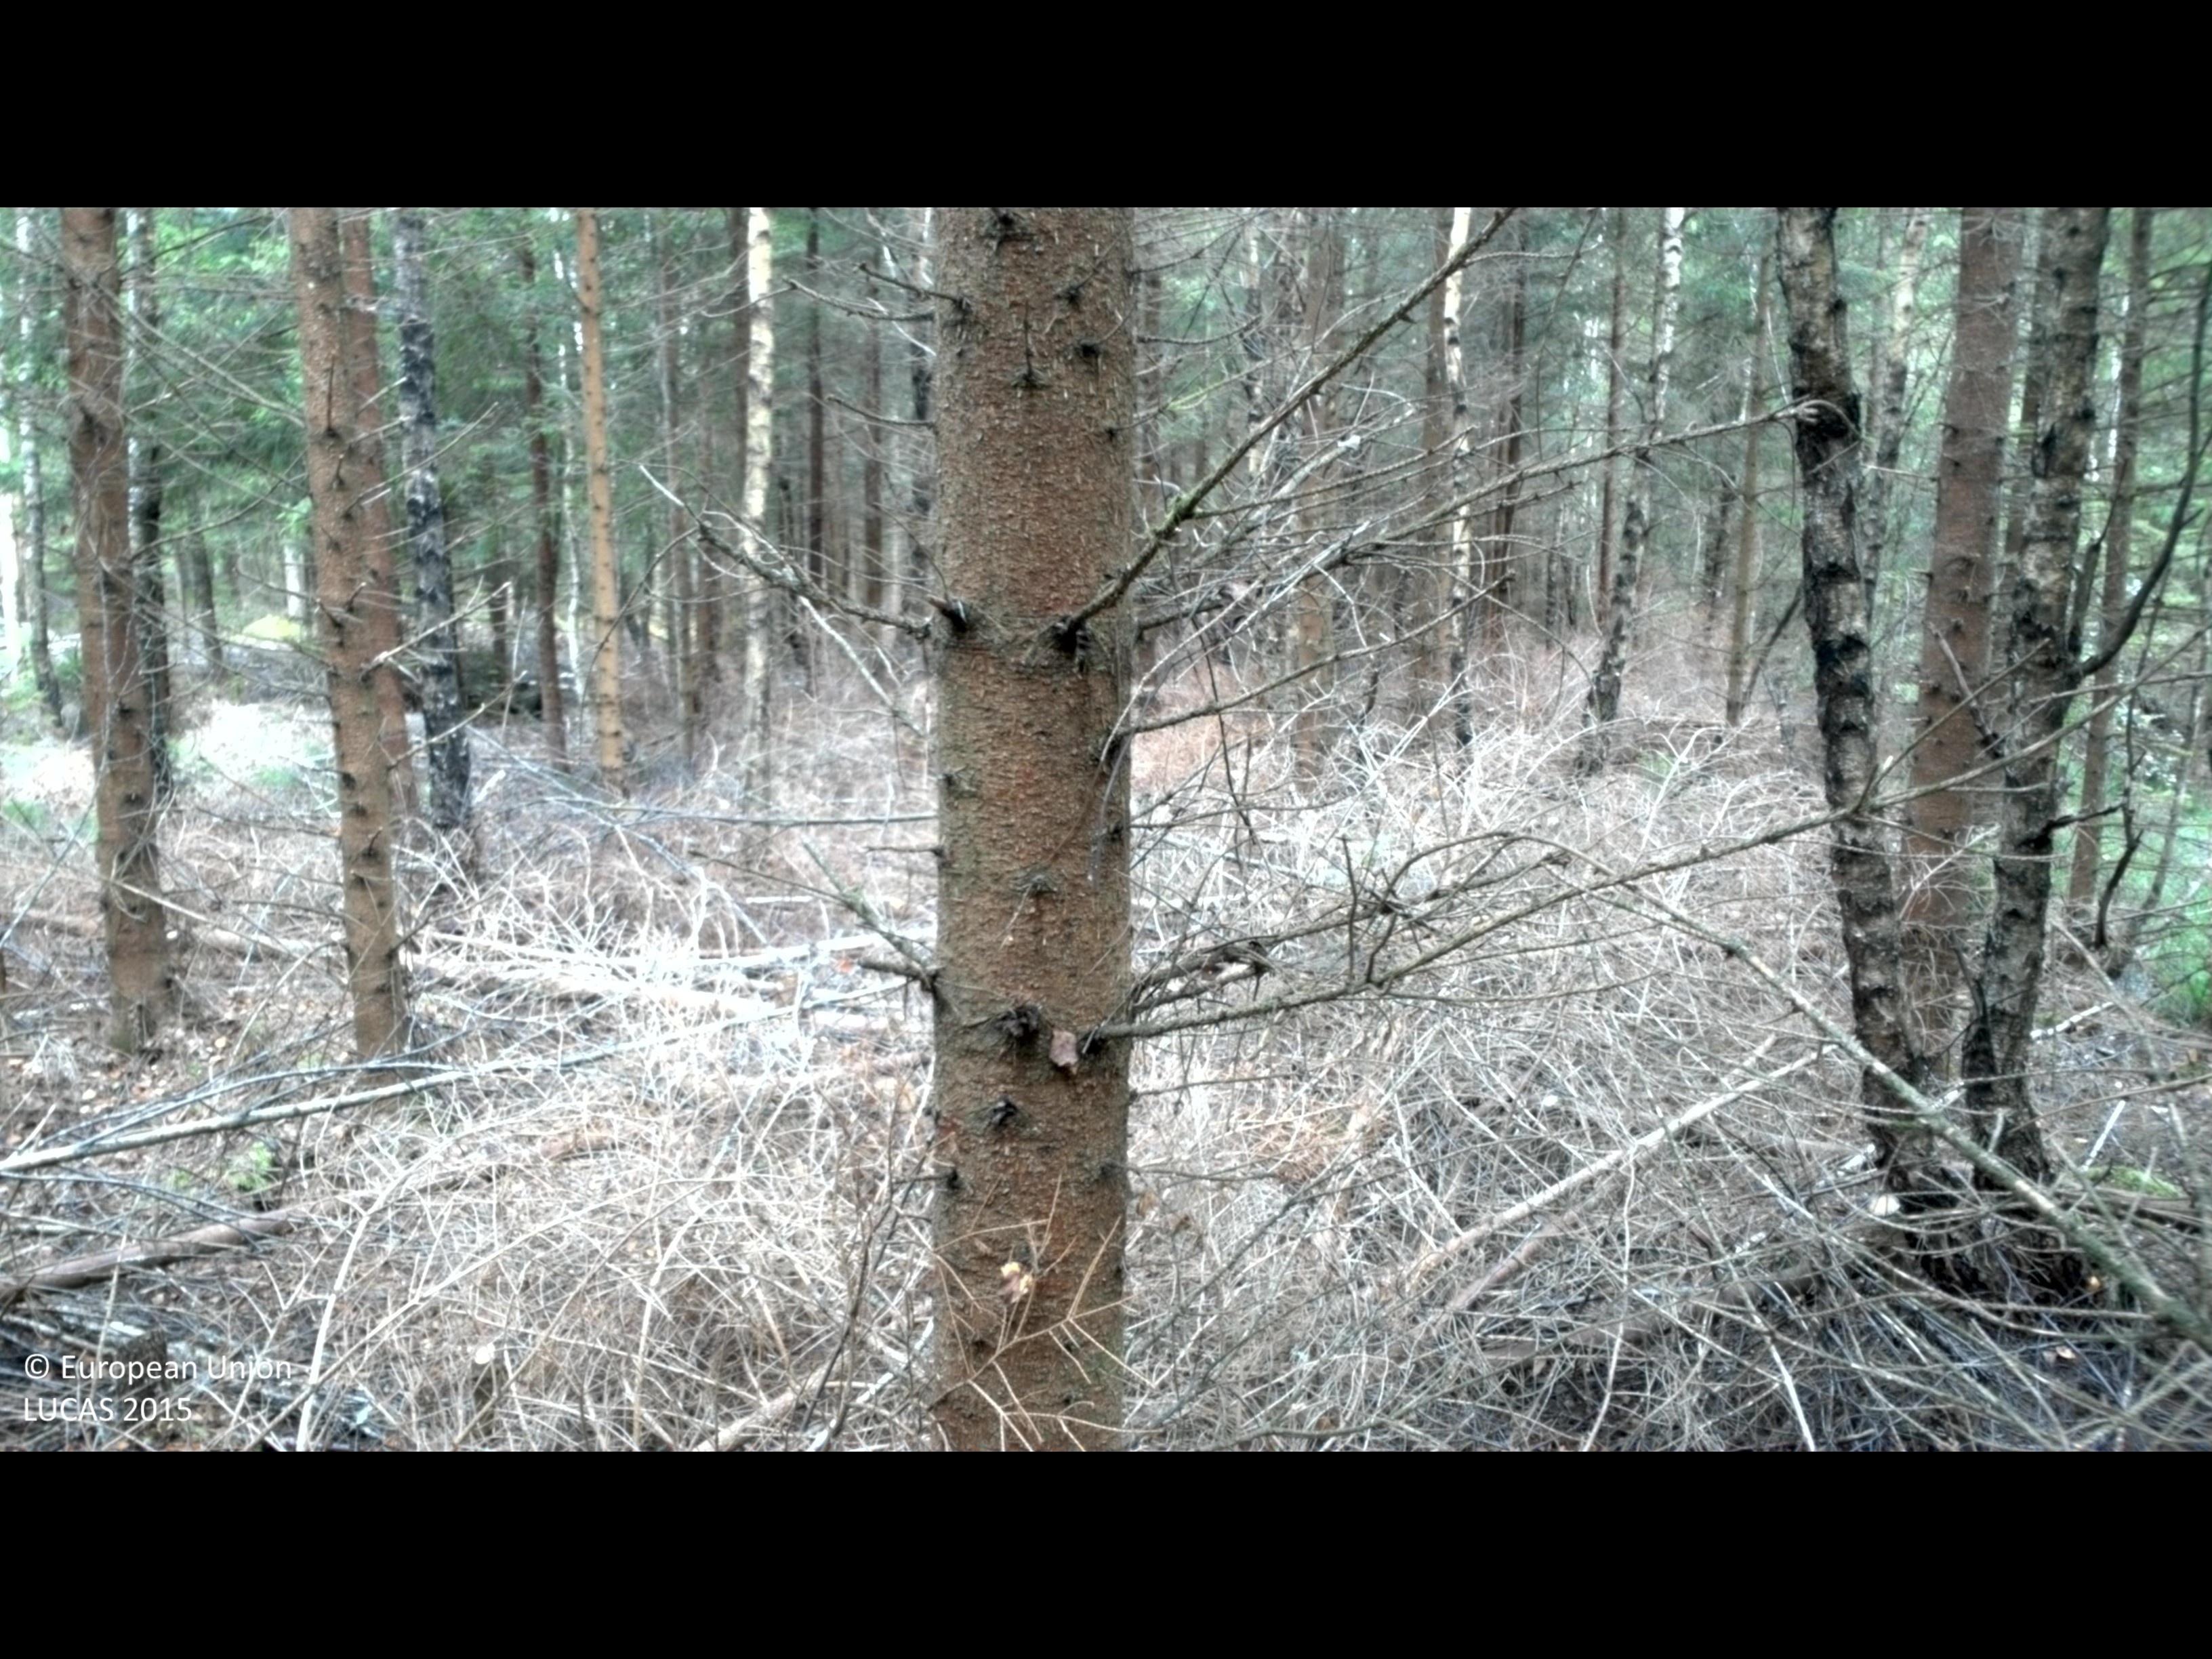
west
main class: Woodland
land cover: Spruce dominated mixed woodland
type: boreal forest
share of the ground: 50 - 75 %
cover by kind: coniferous forest trees 50 %, broadleaved forest trees 20 %
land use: Forestry
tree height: > 5 m
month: August
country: SE
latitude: 56.3356
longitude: 14.1869
